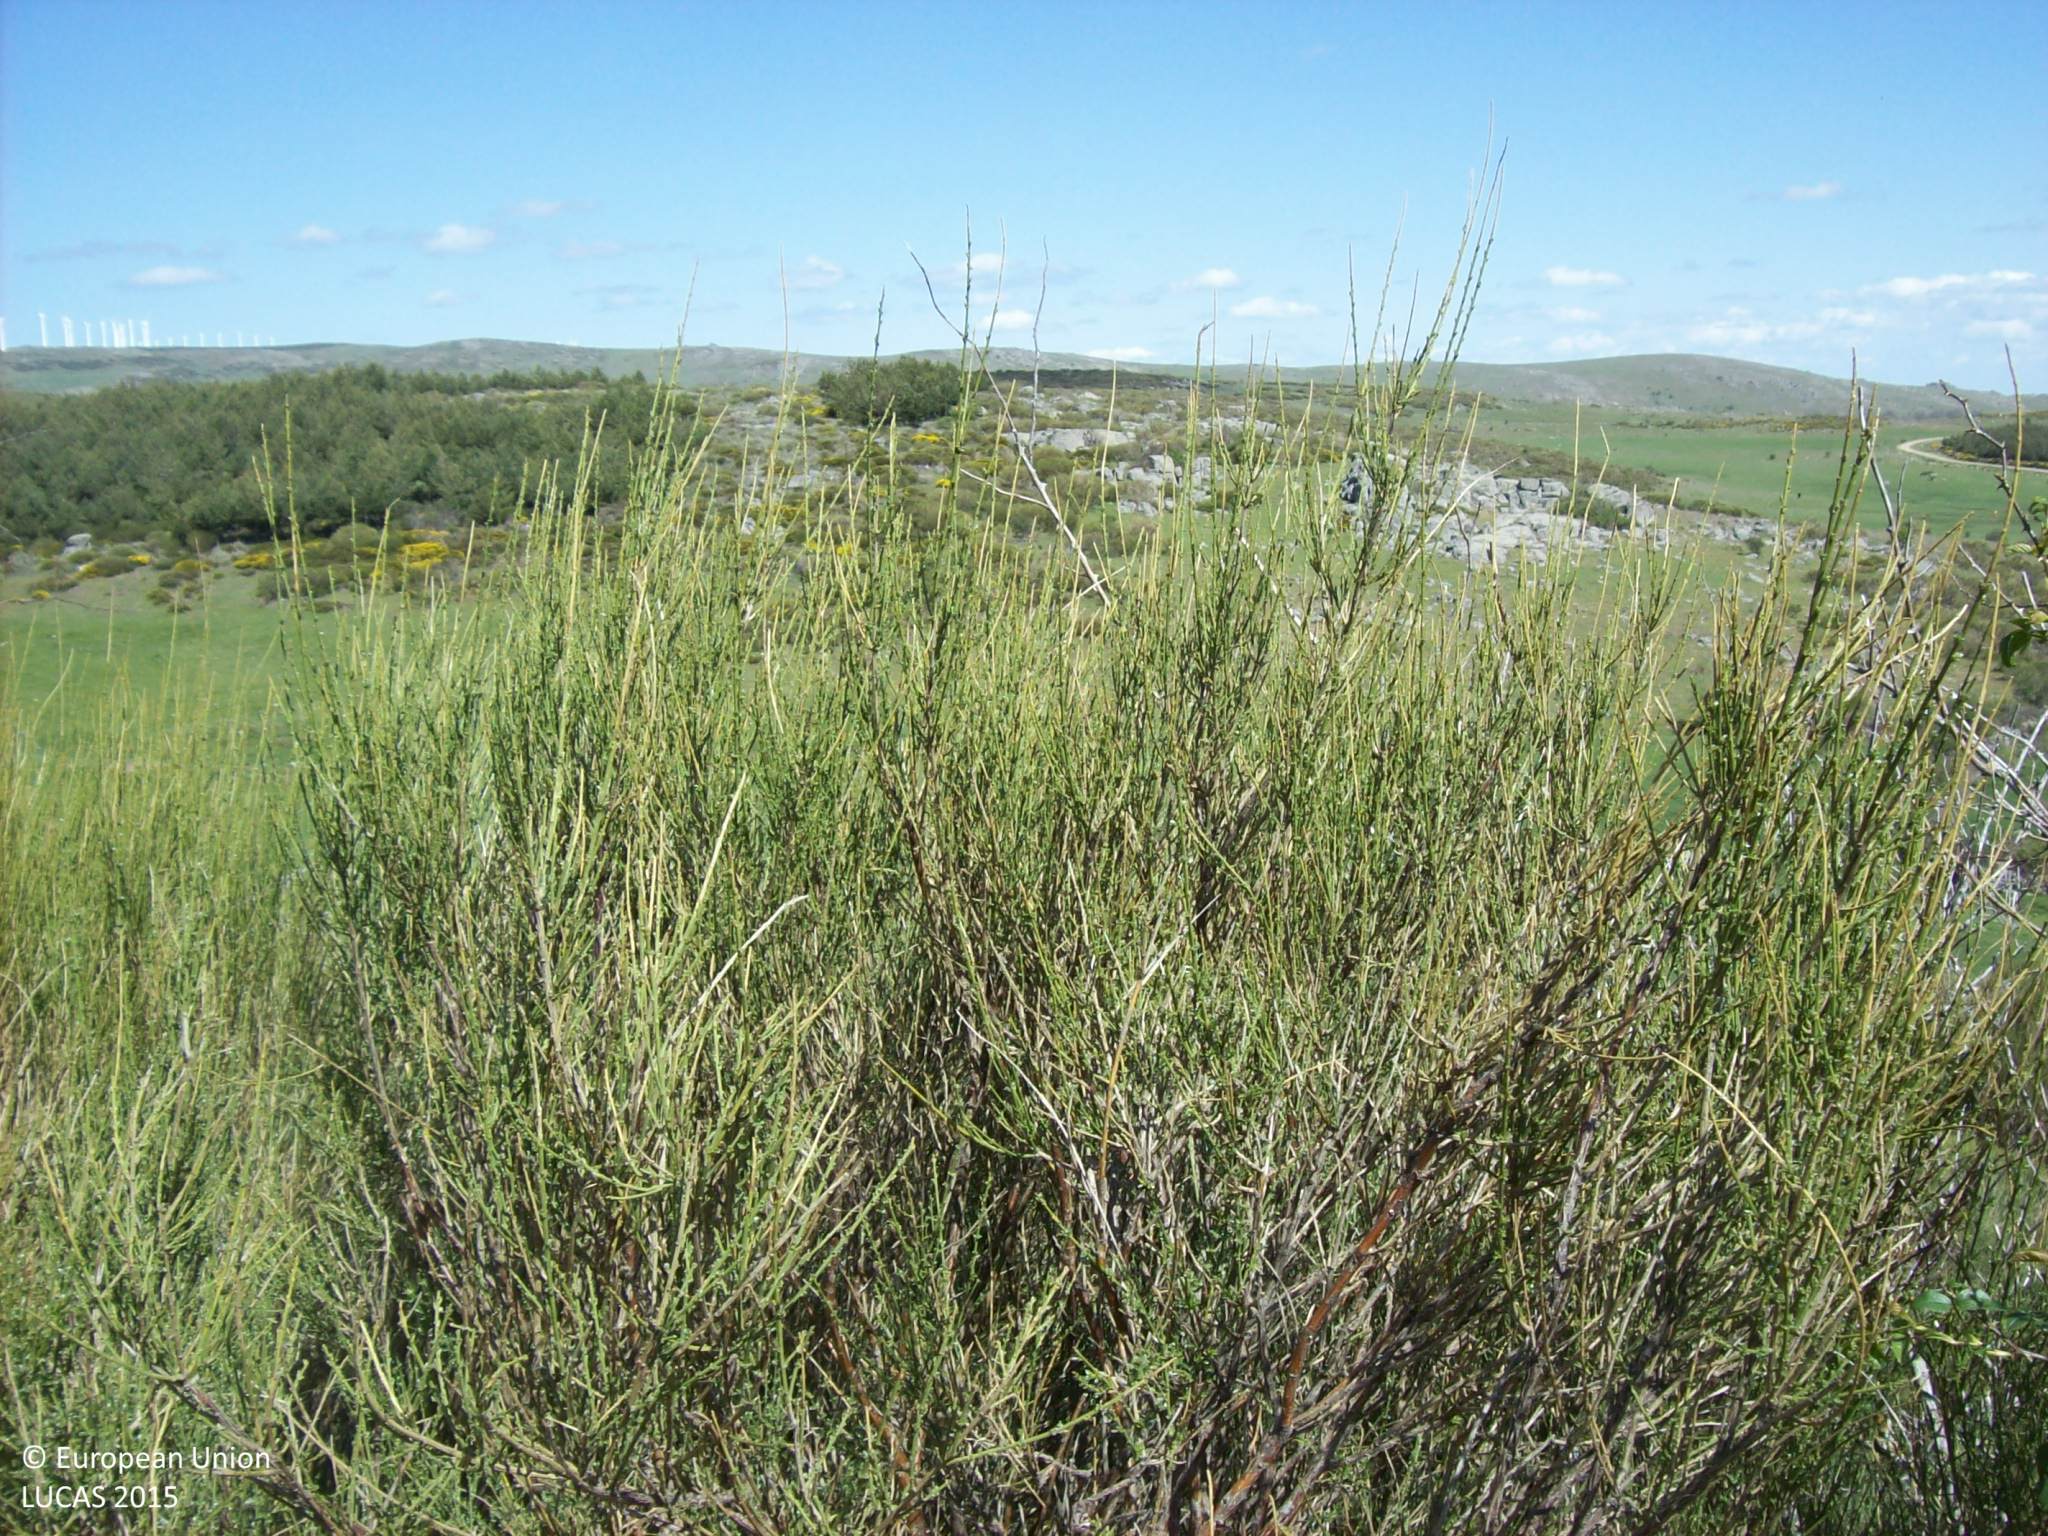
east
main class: Shrubland
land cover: Shrubland without tree cover
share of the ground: > 75 %
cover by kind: shrubs 95 %, herbaceous plants 5 %
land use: Agriculture (excluding fallow land and kitchen gardens)
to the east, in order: Shrubland without tree cover; Tracks; Shrubland without tree cover; Grassland without tree/shrub cover; Rivers and streams; Grassland without tree/shrub cover; Shrubland without tree cover; Fences; Pine dominated coniferous woodland; Rock outcrops; Shrubland without tree cover
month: May
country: ES
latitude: 40.6238
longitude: -4.4377
